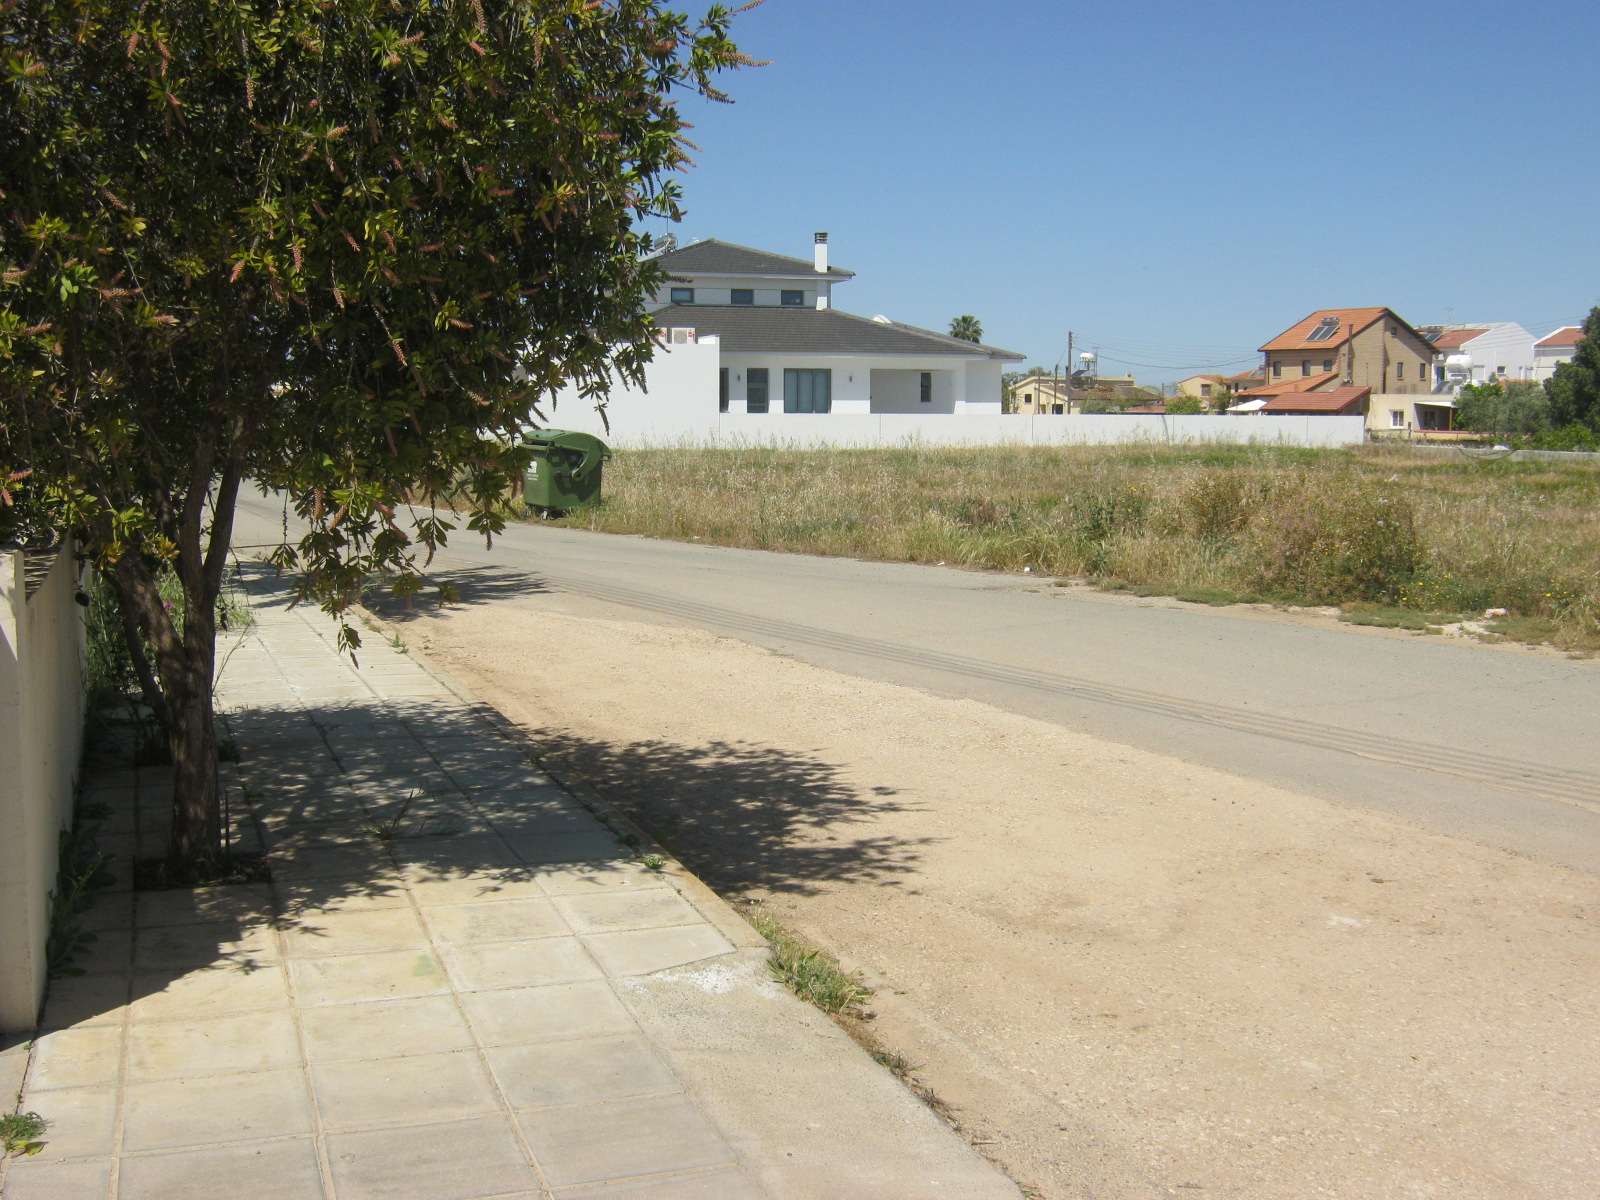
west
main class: Artificial land
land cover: Non built-up linear features
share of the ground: > 75 %
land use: Road transport
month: May
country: CY
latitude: 35.1536
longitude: 33.2066
